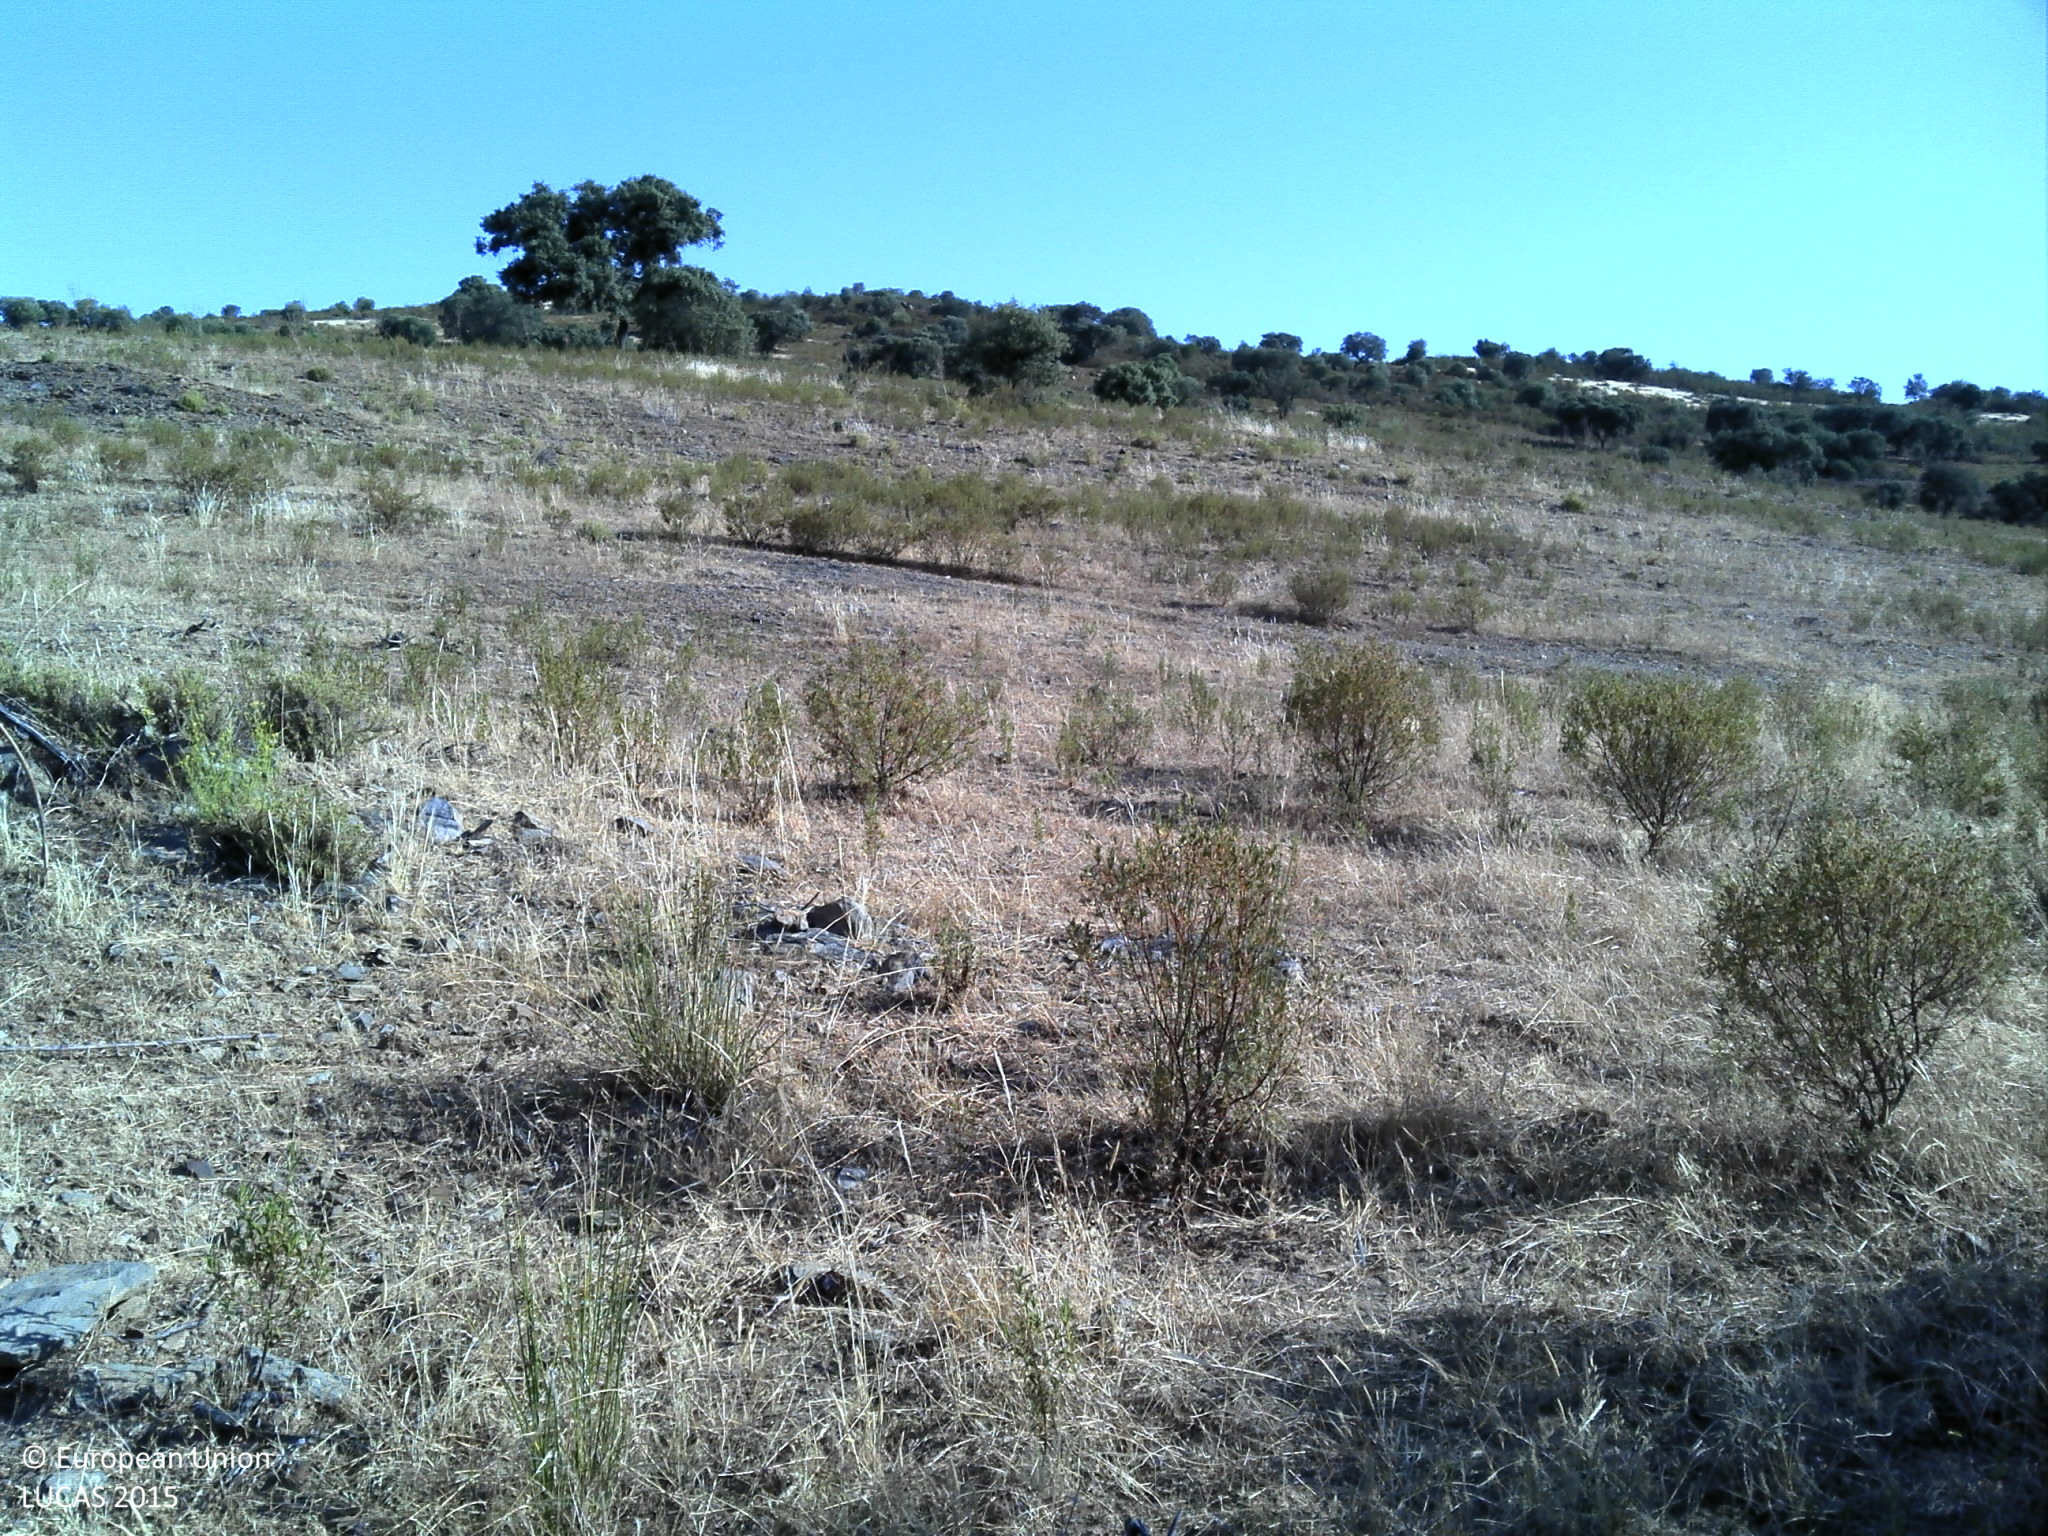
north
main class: Grassland
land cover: Grassland with sparse tree/shrub cover
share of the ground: 50 - 75 %
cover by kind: herbaceous plants 85 %, shrubs 10 %, broadleaved forest trees 5 %
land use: Agriculture (excluding fallow land and kitchen gardens)
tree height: < 5 m
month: June
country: PT
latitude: 37.6606
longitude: -7.6197
